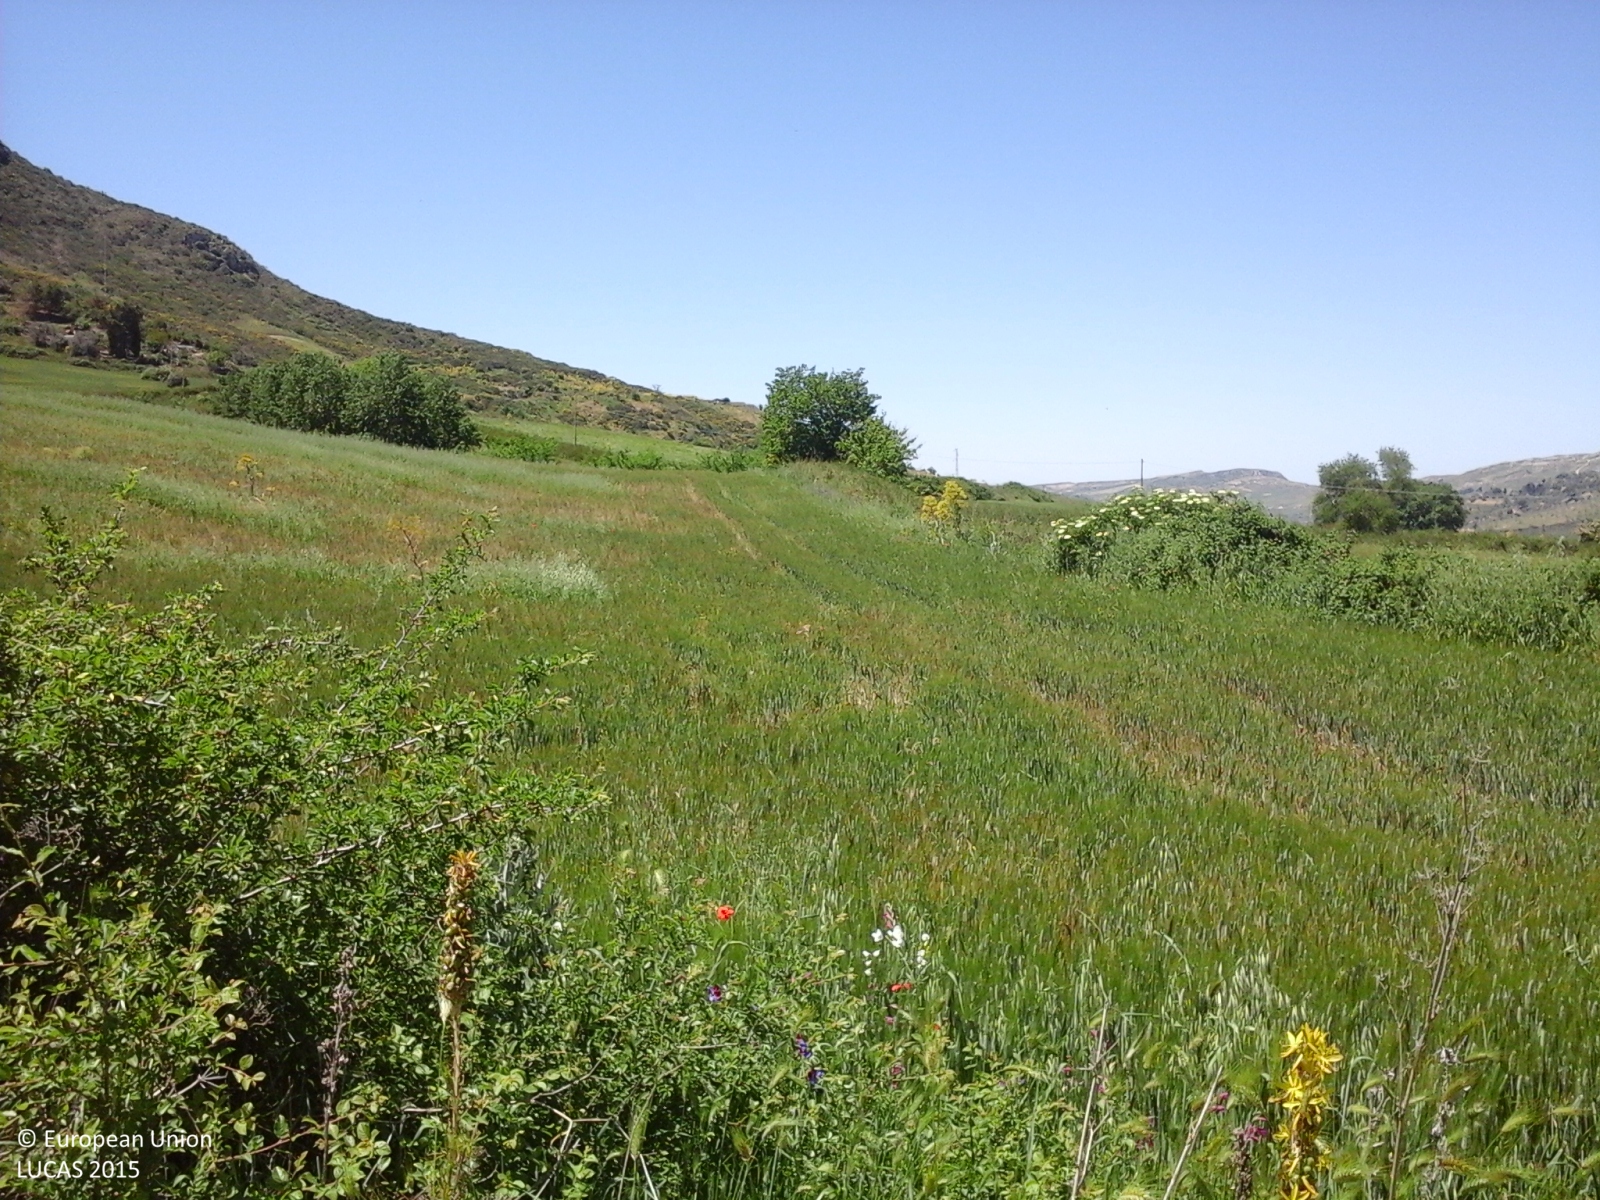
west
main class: Cropland
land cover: Durum wheat
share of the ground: > 75 %
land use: Agriculture (excluding fallow land and kitchen gardens)
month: May
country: IT
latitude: 37.5240
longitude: 14.2794
